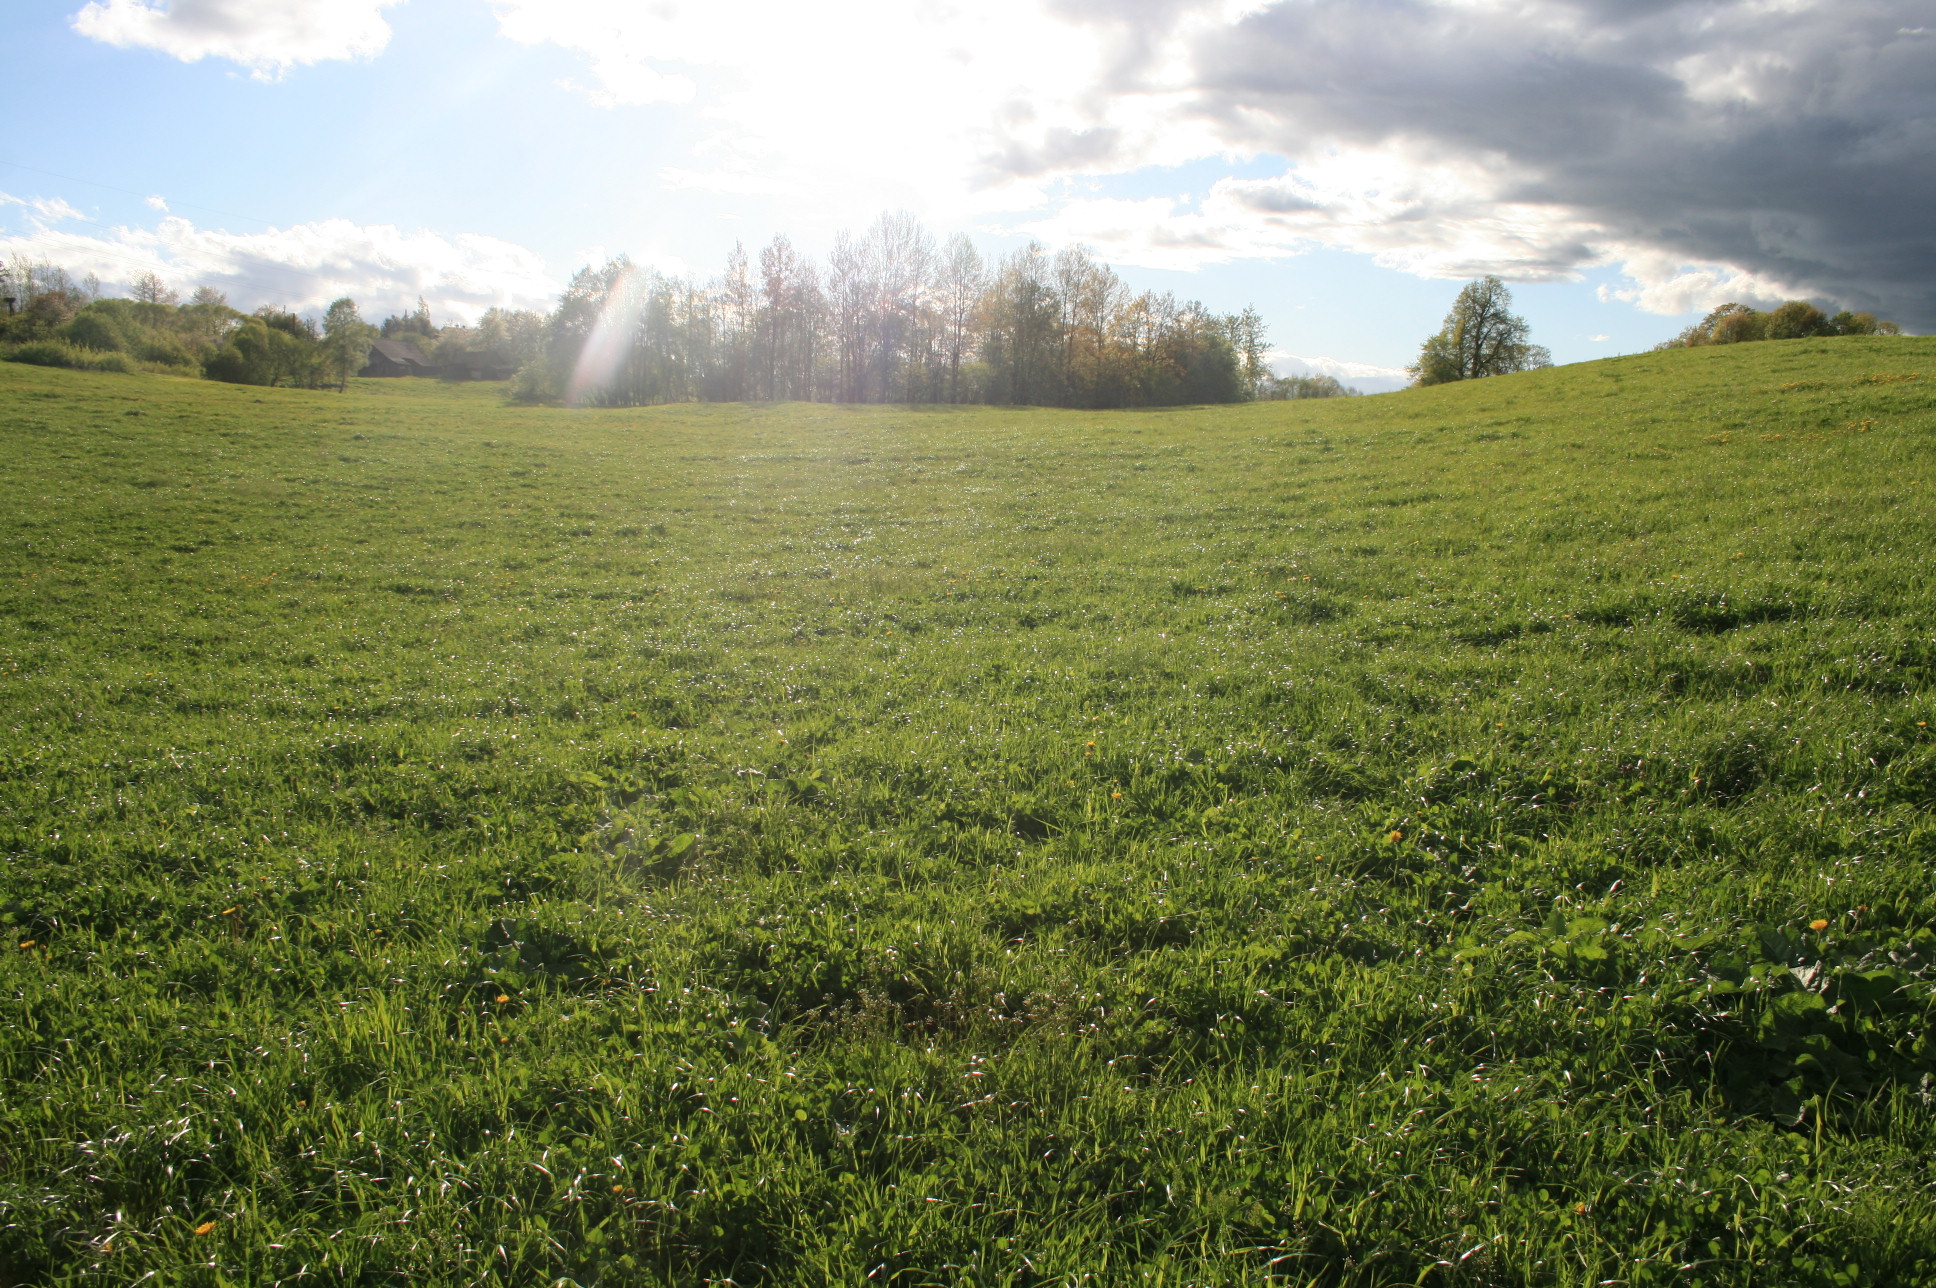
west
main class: Grassland
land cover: Grassland without tree/shrub cover
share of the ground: > 75 %
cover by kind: herbaceous plants 100 %
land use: Agriculture (excluding fallow land and kitchen gardens)
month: May
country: LT
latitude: 56.0576
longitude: 22.0150
